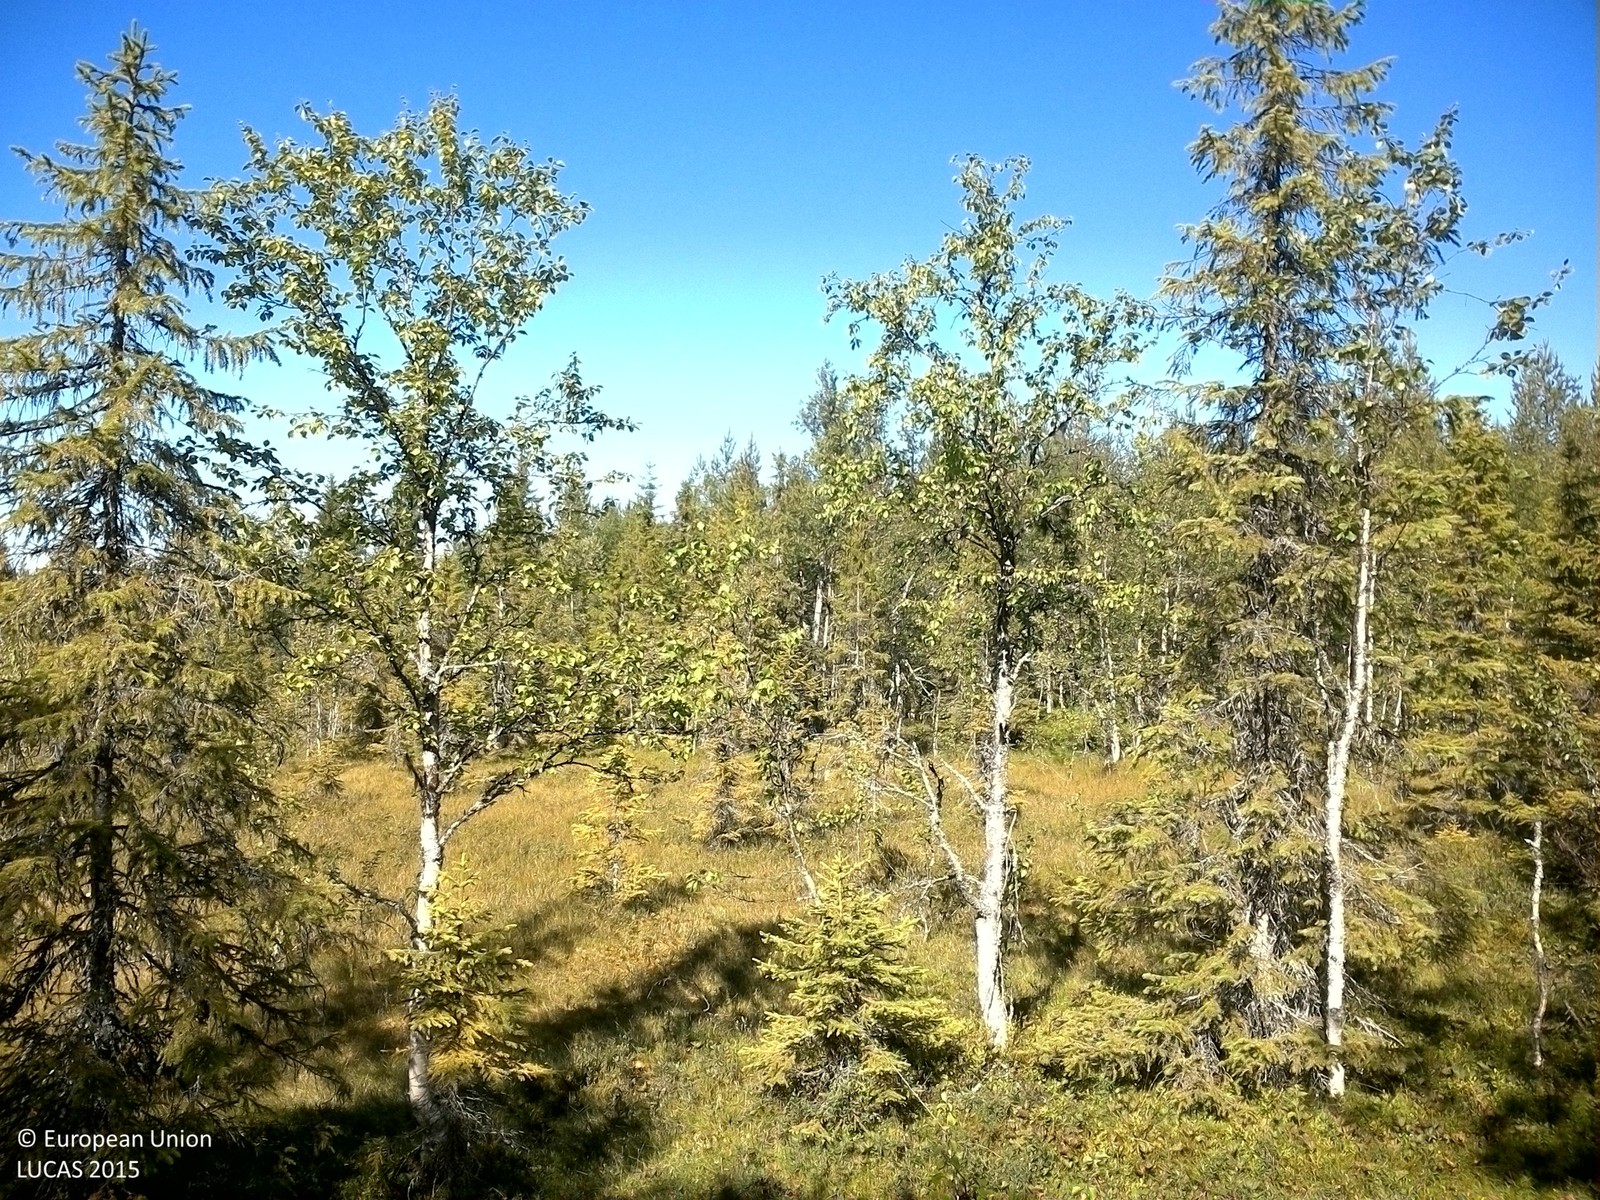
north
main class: Woodland
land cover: Broadleaved woodland
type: boreal forest
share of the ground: 25 - 50 %
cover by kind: shrubs 50 %, broadleaved forest trees 40 %, coniferous forest trees 5 %, lichens and mosses 5 %
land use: Forestry
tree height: < 5 m
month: August
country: SE
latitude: 63.8810
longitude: 17.7693
